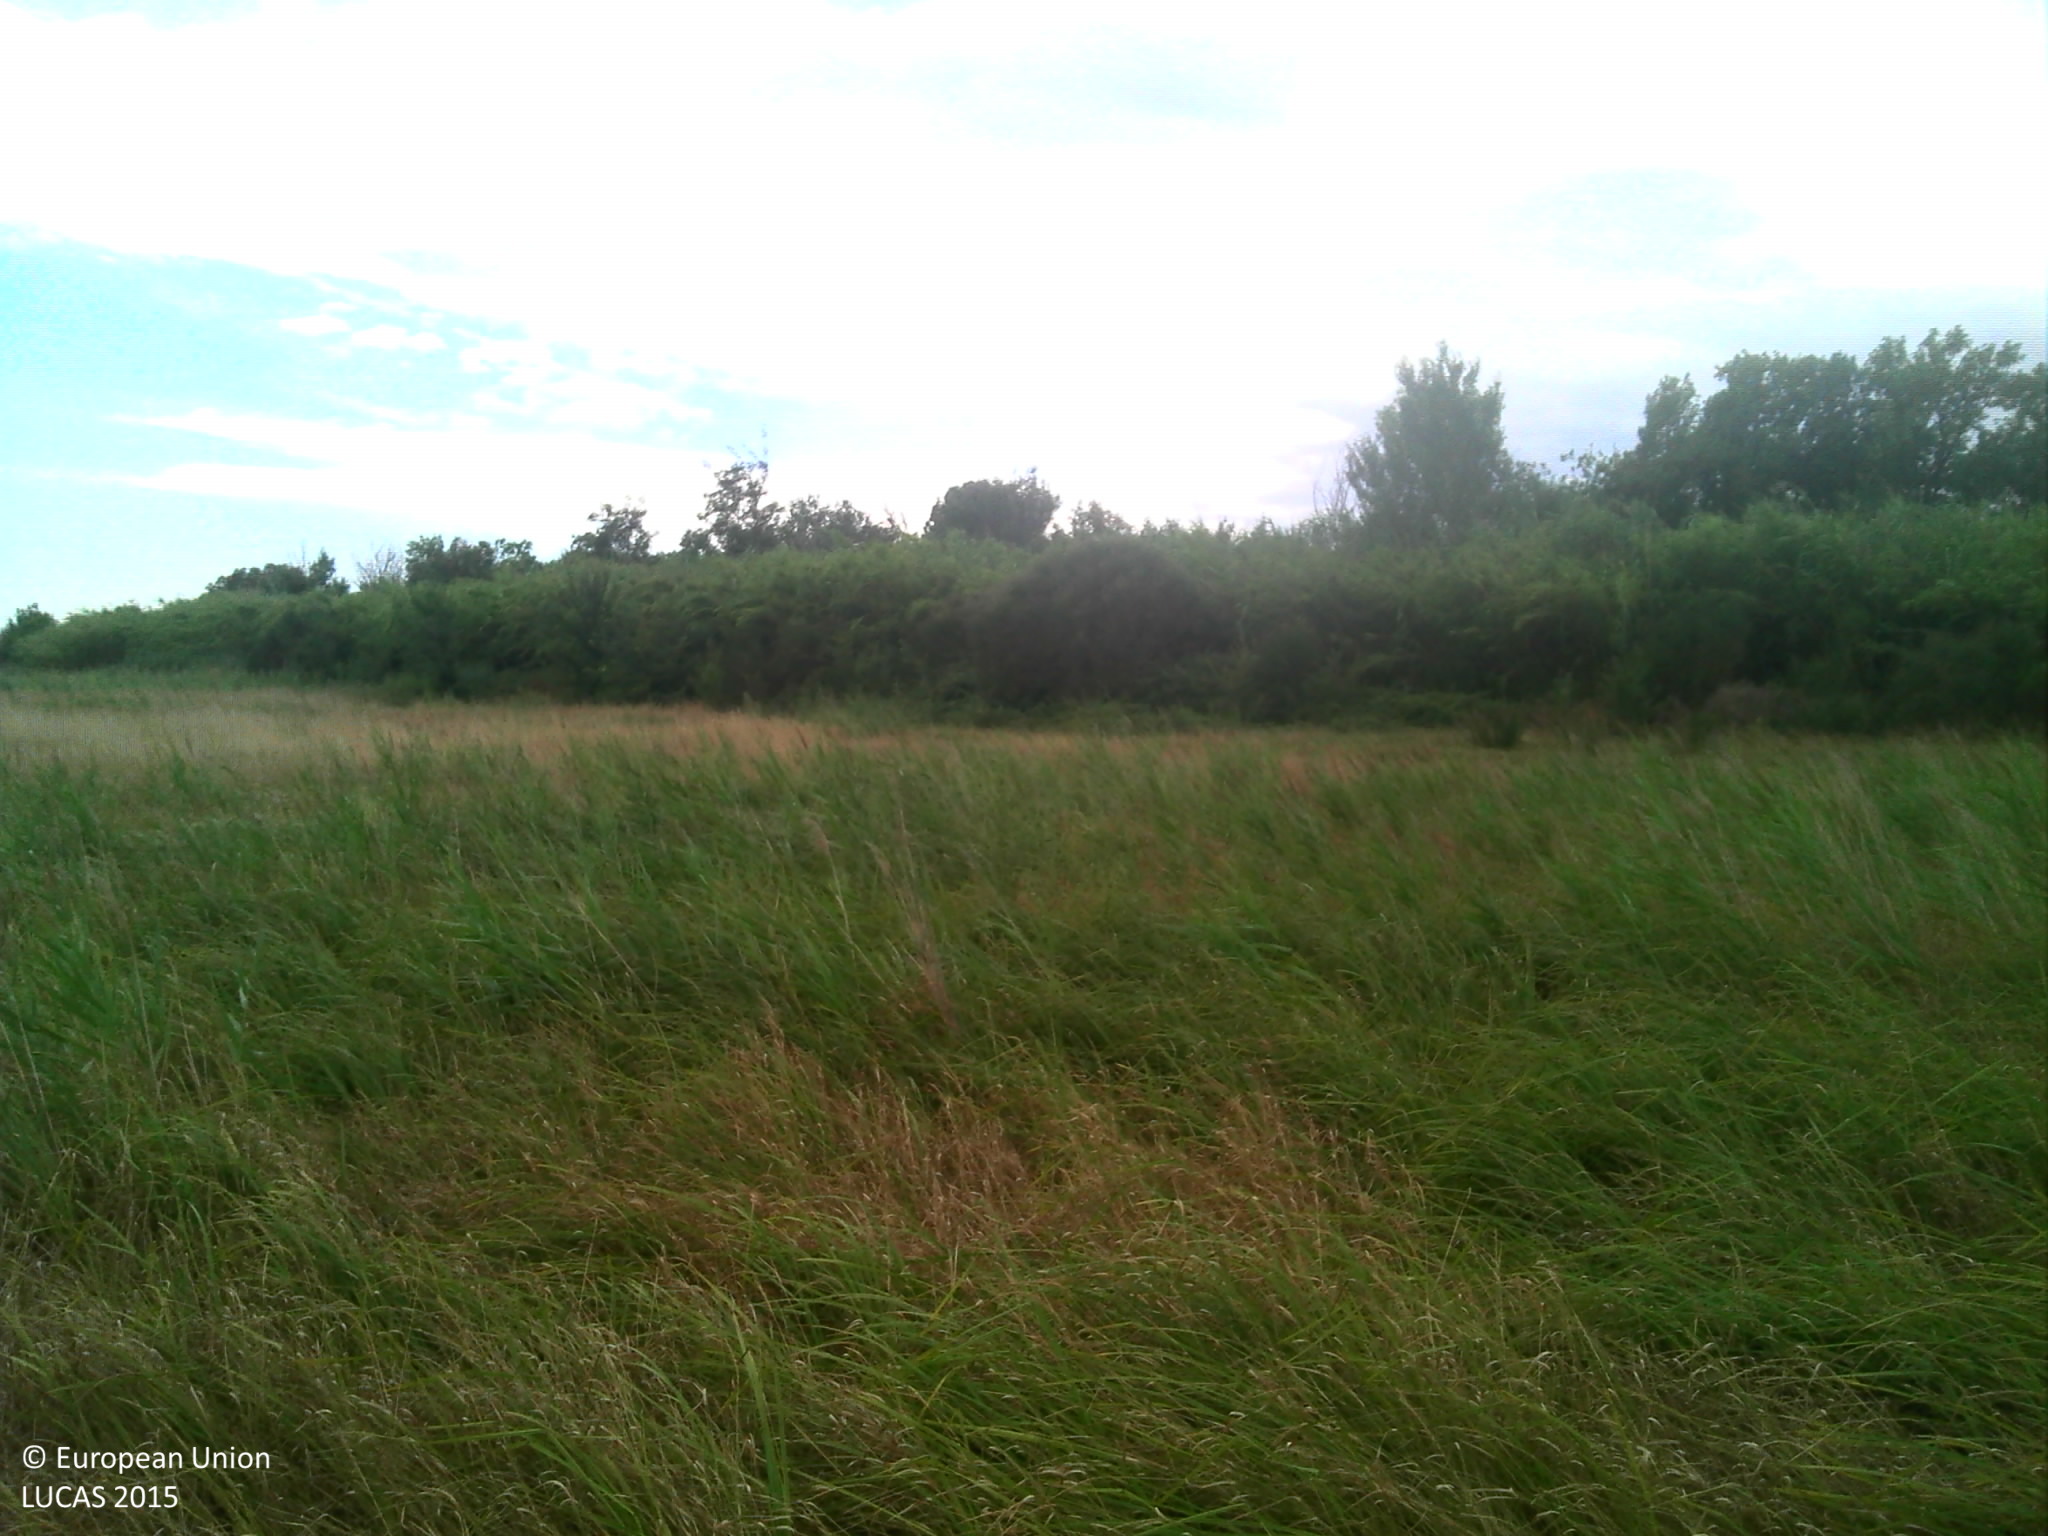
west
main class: Grassland
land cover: Grassland without tree/shrub cover
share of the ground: > 75 %
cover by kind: herbaceous plants 95 %, shrubs 5 %
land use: Semi-natural and natural areas not in use
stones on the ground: < 10 %
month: July
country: FR
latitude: 43.5275
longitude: 5.0483
